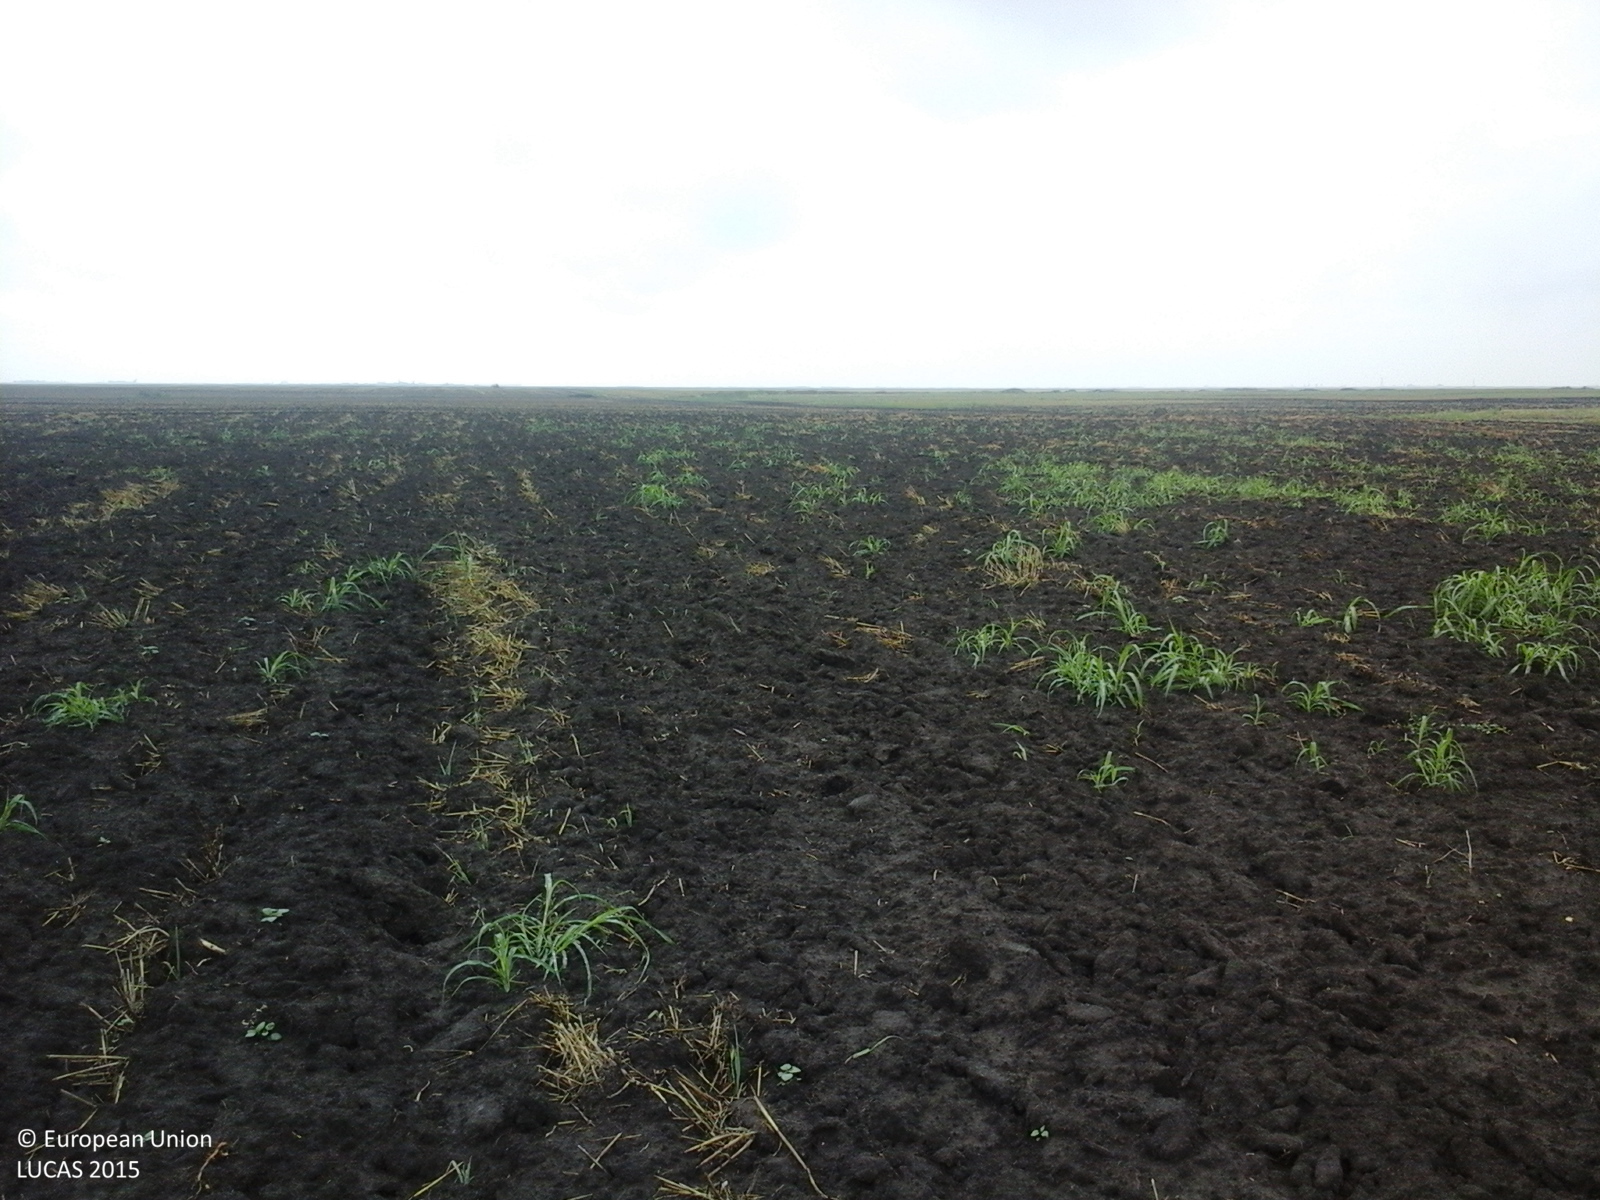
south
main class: Cropland
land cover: Common wheat
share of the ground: < 10 %
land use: Agriculture (excluding fallow land and kitchen gardens)
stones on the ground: < 10 %
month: August
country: RO
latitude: 46.0172
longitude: 20.4733
